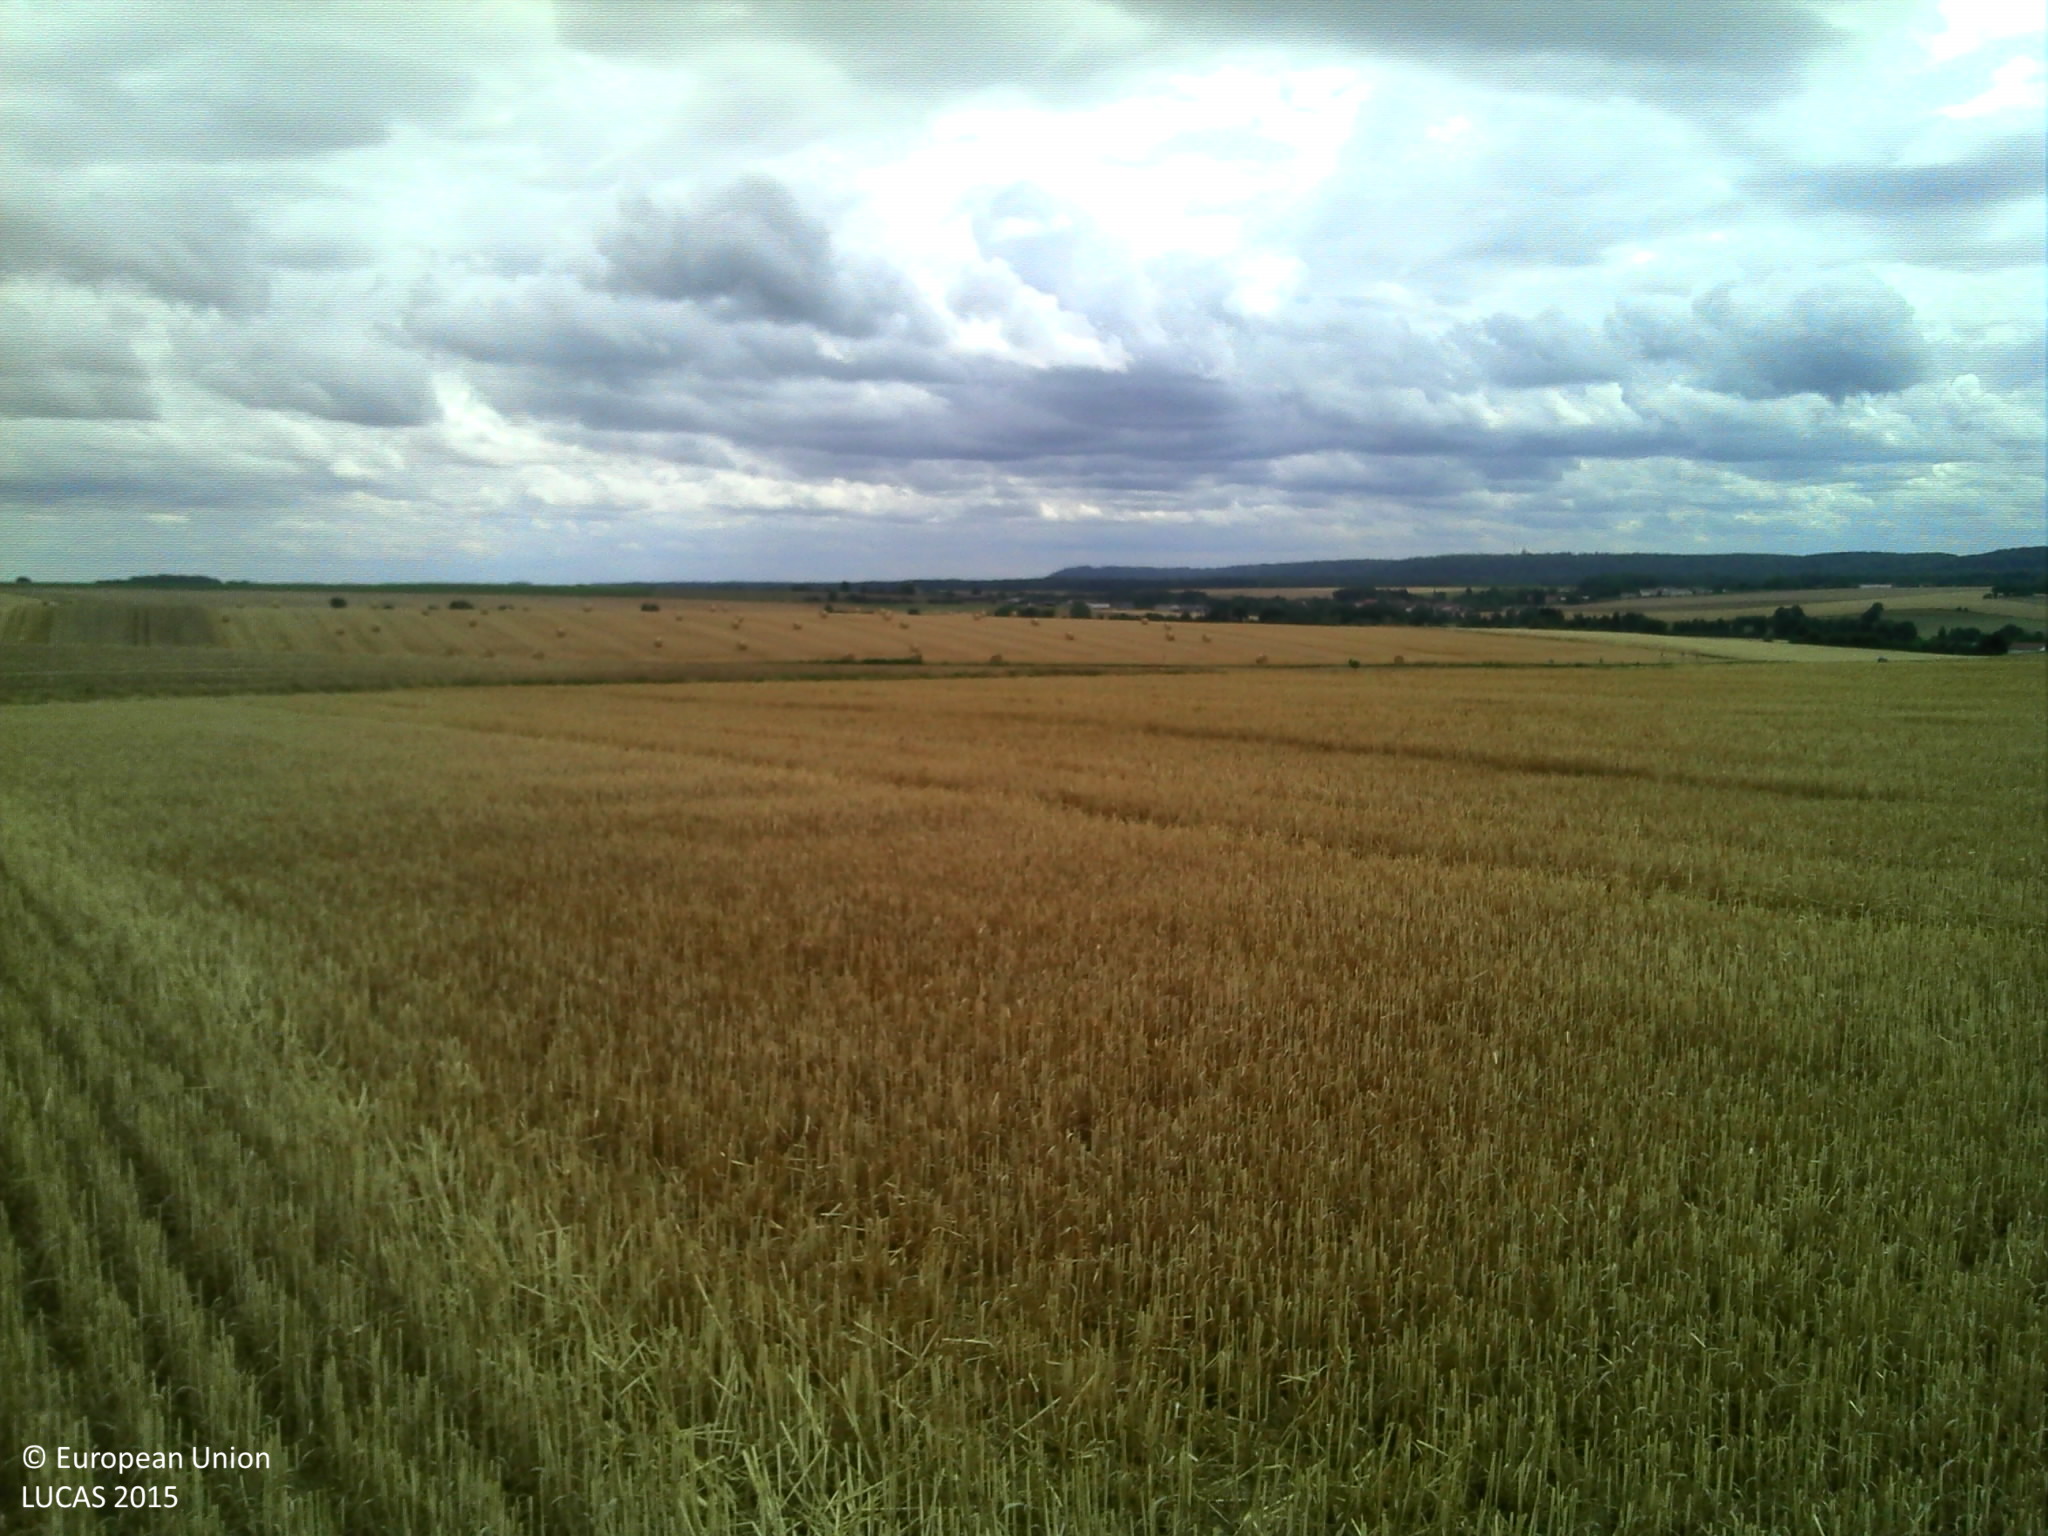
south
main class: Cropland
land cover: Common wheat
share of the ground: > 75 %
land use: Agriculture (excluding fallow land and kitchen gardens)
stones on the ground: < 10 %
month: July
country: FR
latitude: 49.1243
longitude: 5.1060
